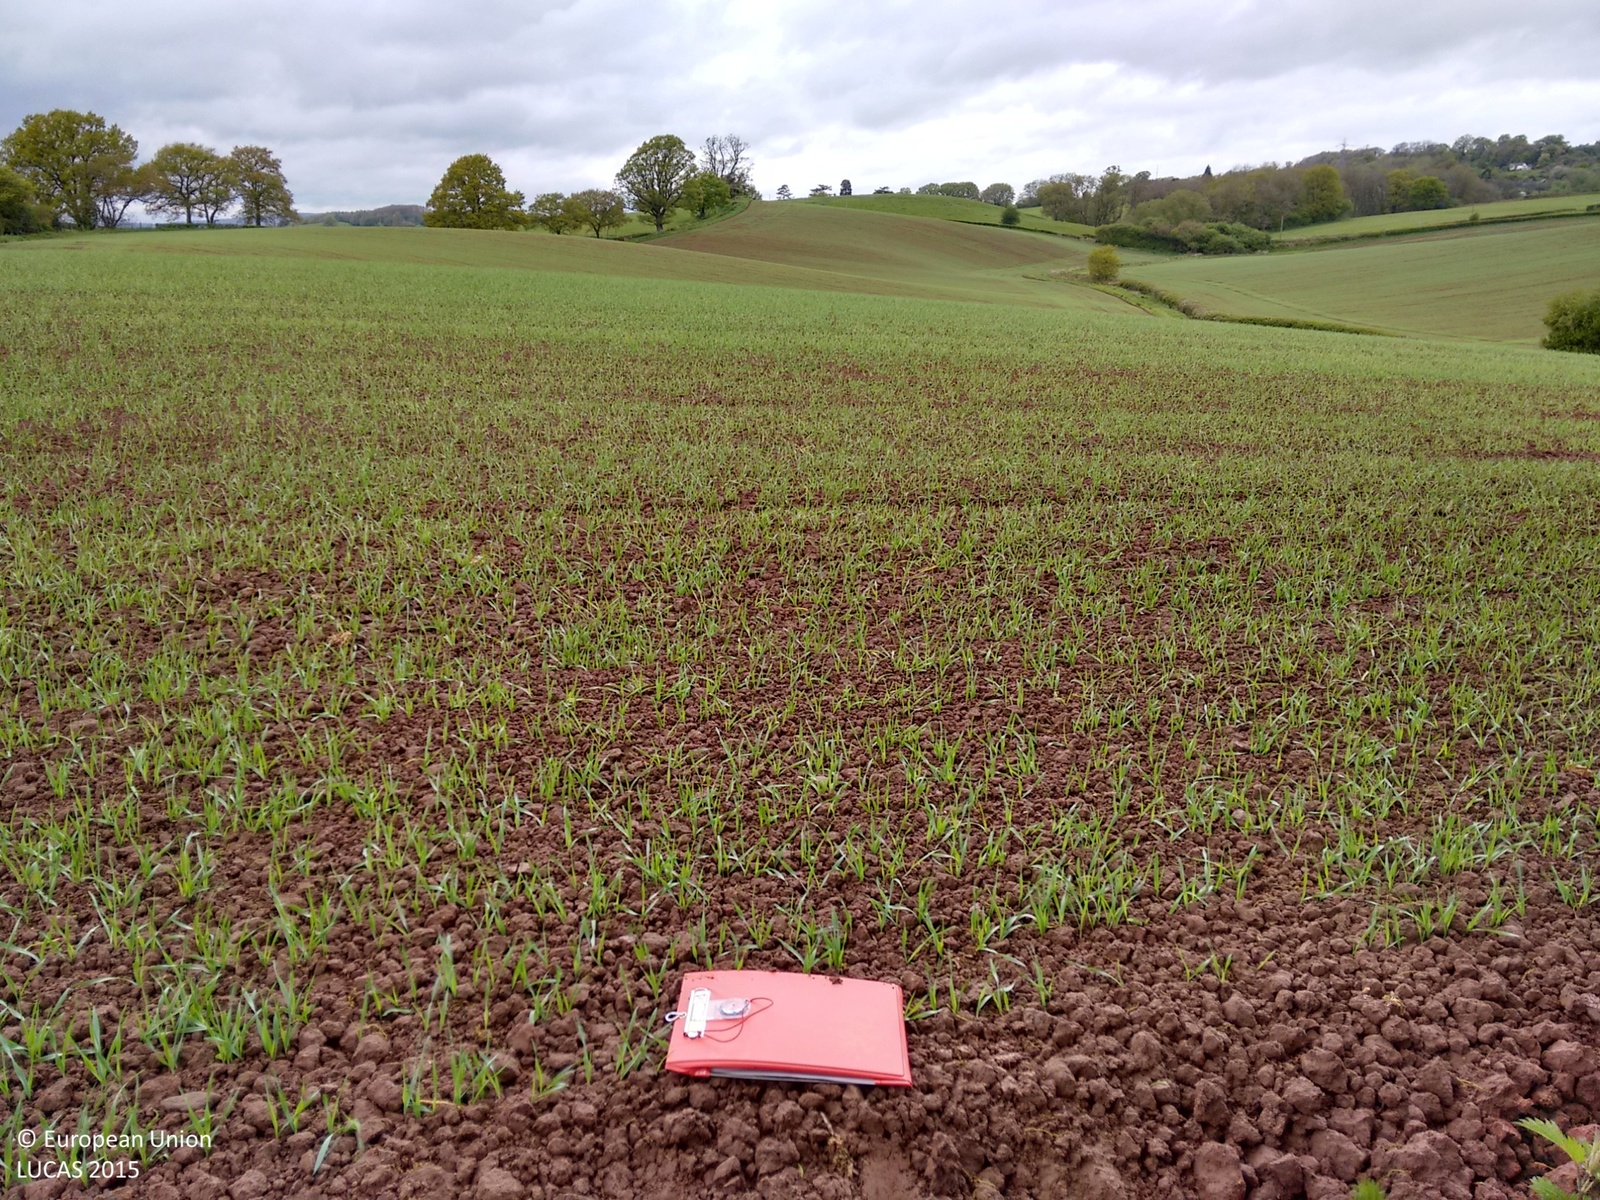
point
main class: Cropland
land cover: Barley
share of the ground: 25 - 50 %
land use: Agriculture (excluding fallow land and kitchen gardens)
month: May
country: GB
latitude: 52.3036
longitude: -2.4281
